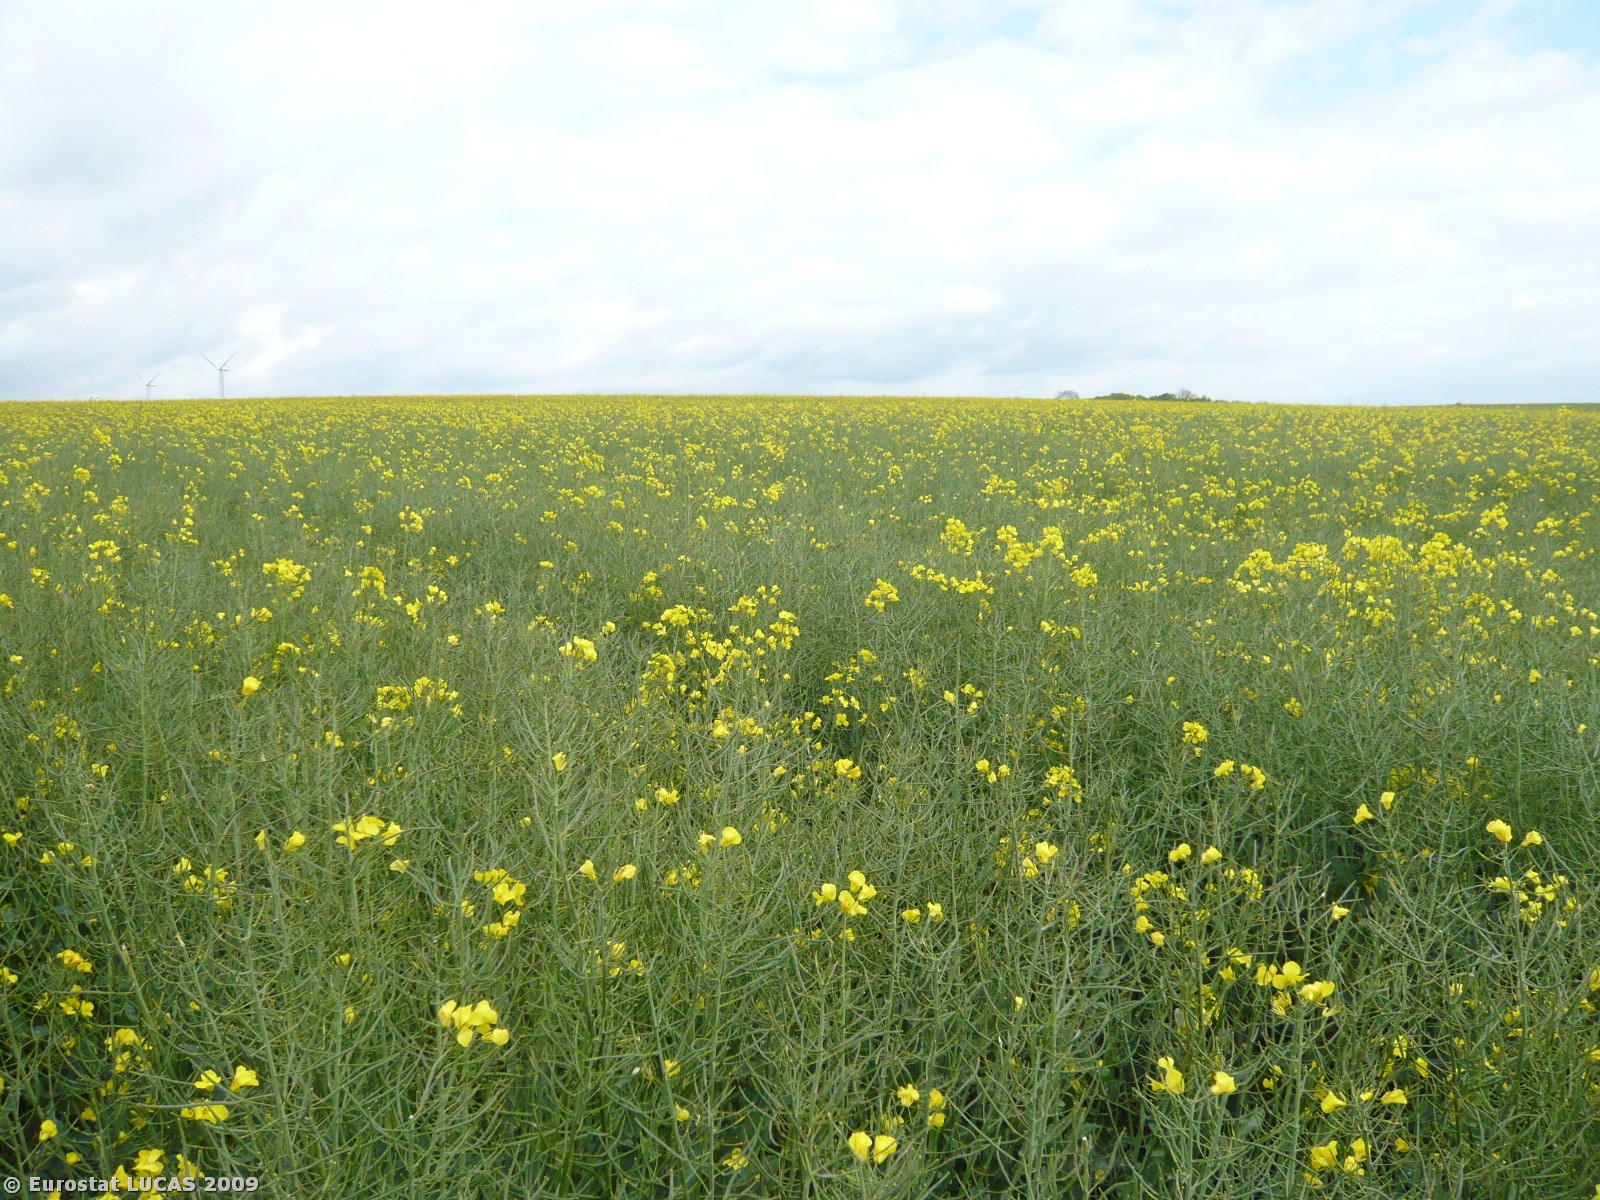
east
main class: Cropland
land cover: Rape and turnip rape
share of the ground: > 75 %
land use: Agriculture (excluding fallow land and kitchen gardens)
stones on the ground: < 10 %
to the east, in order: Rape and turnip rape
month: May
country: DK
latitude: 55.4215
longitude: 11.6891
